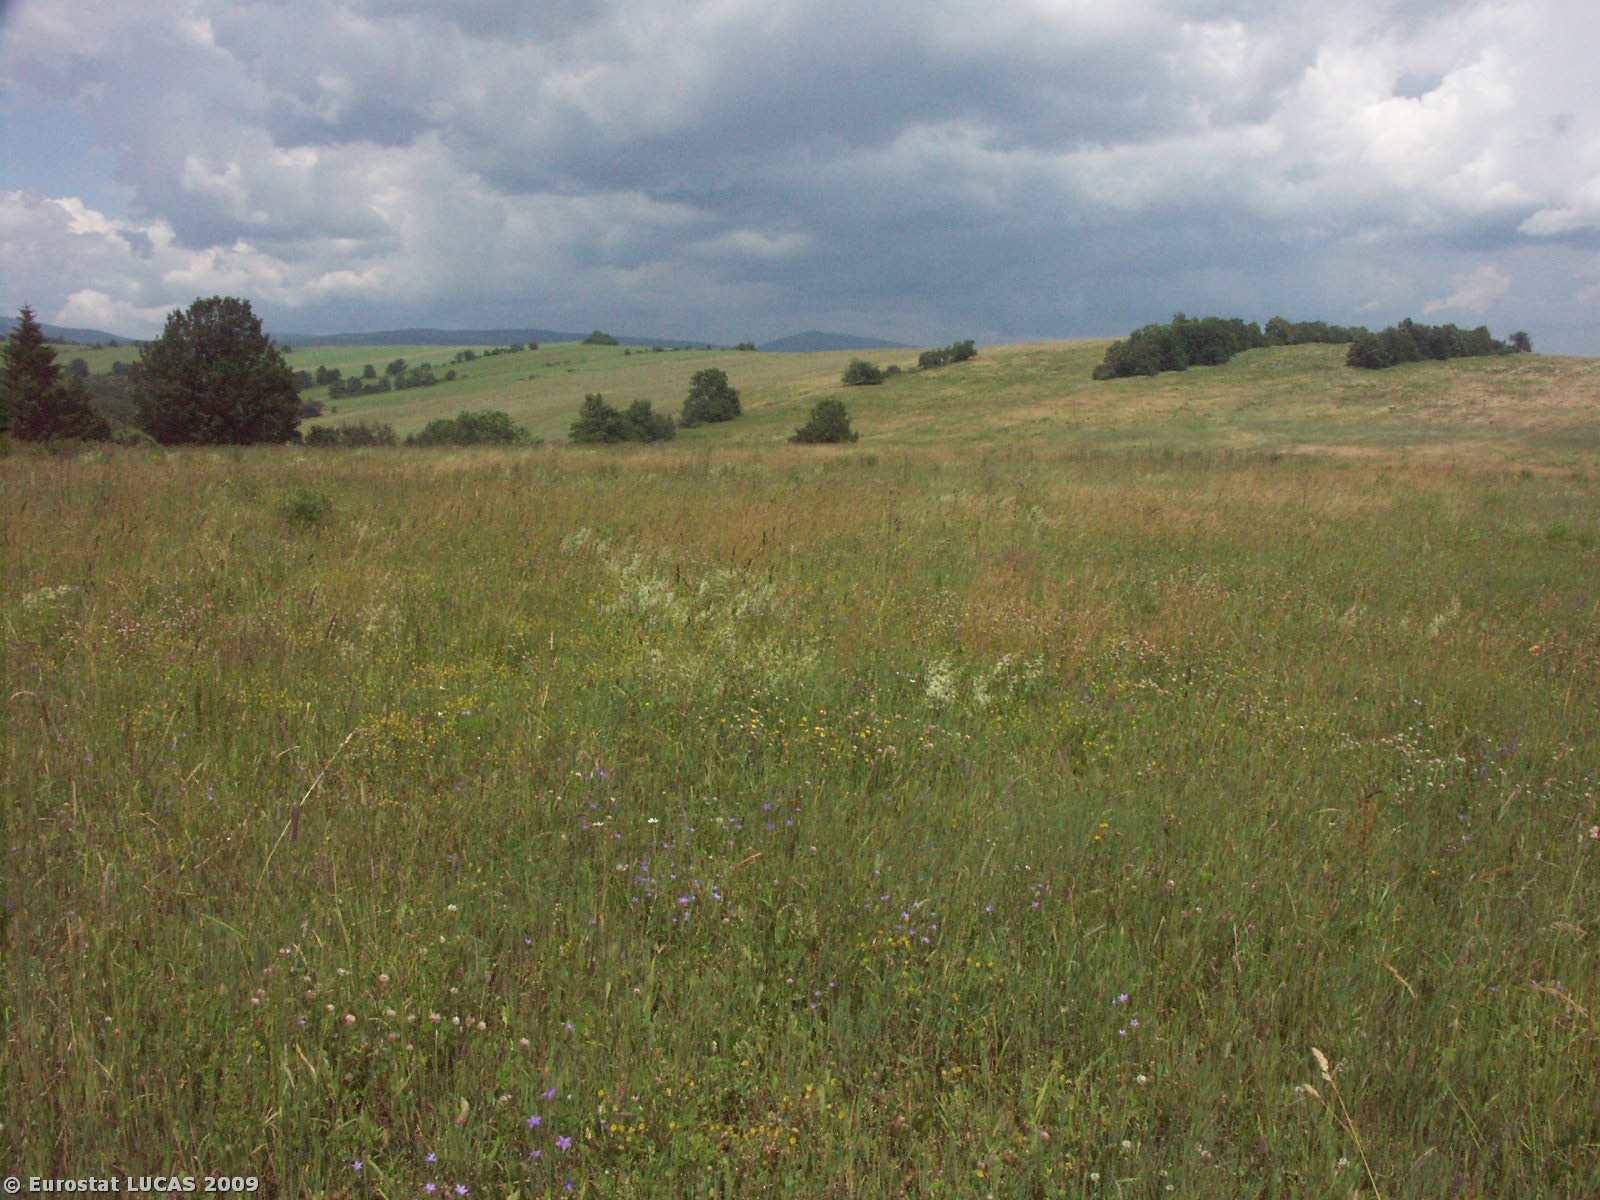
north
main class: Grassland
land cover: Grassland without tree/shrub cover
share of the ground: > 75 %
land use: Agriculture (excluding fallow land and kitchen gardens)
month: July
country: CZ
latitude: 50.0001
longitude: 17.3639
